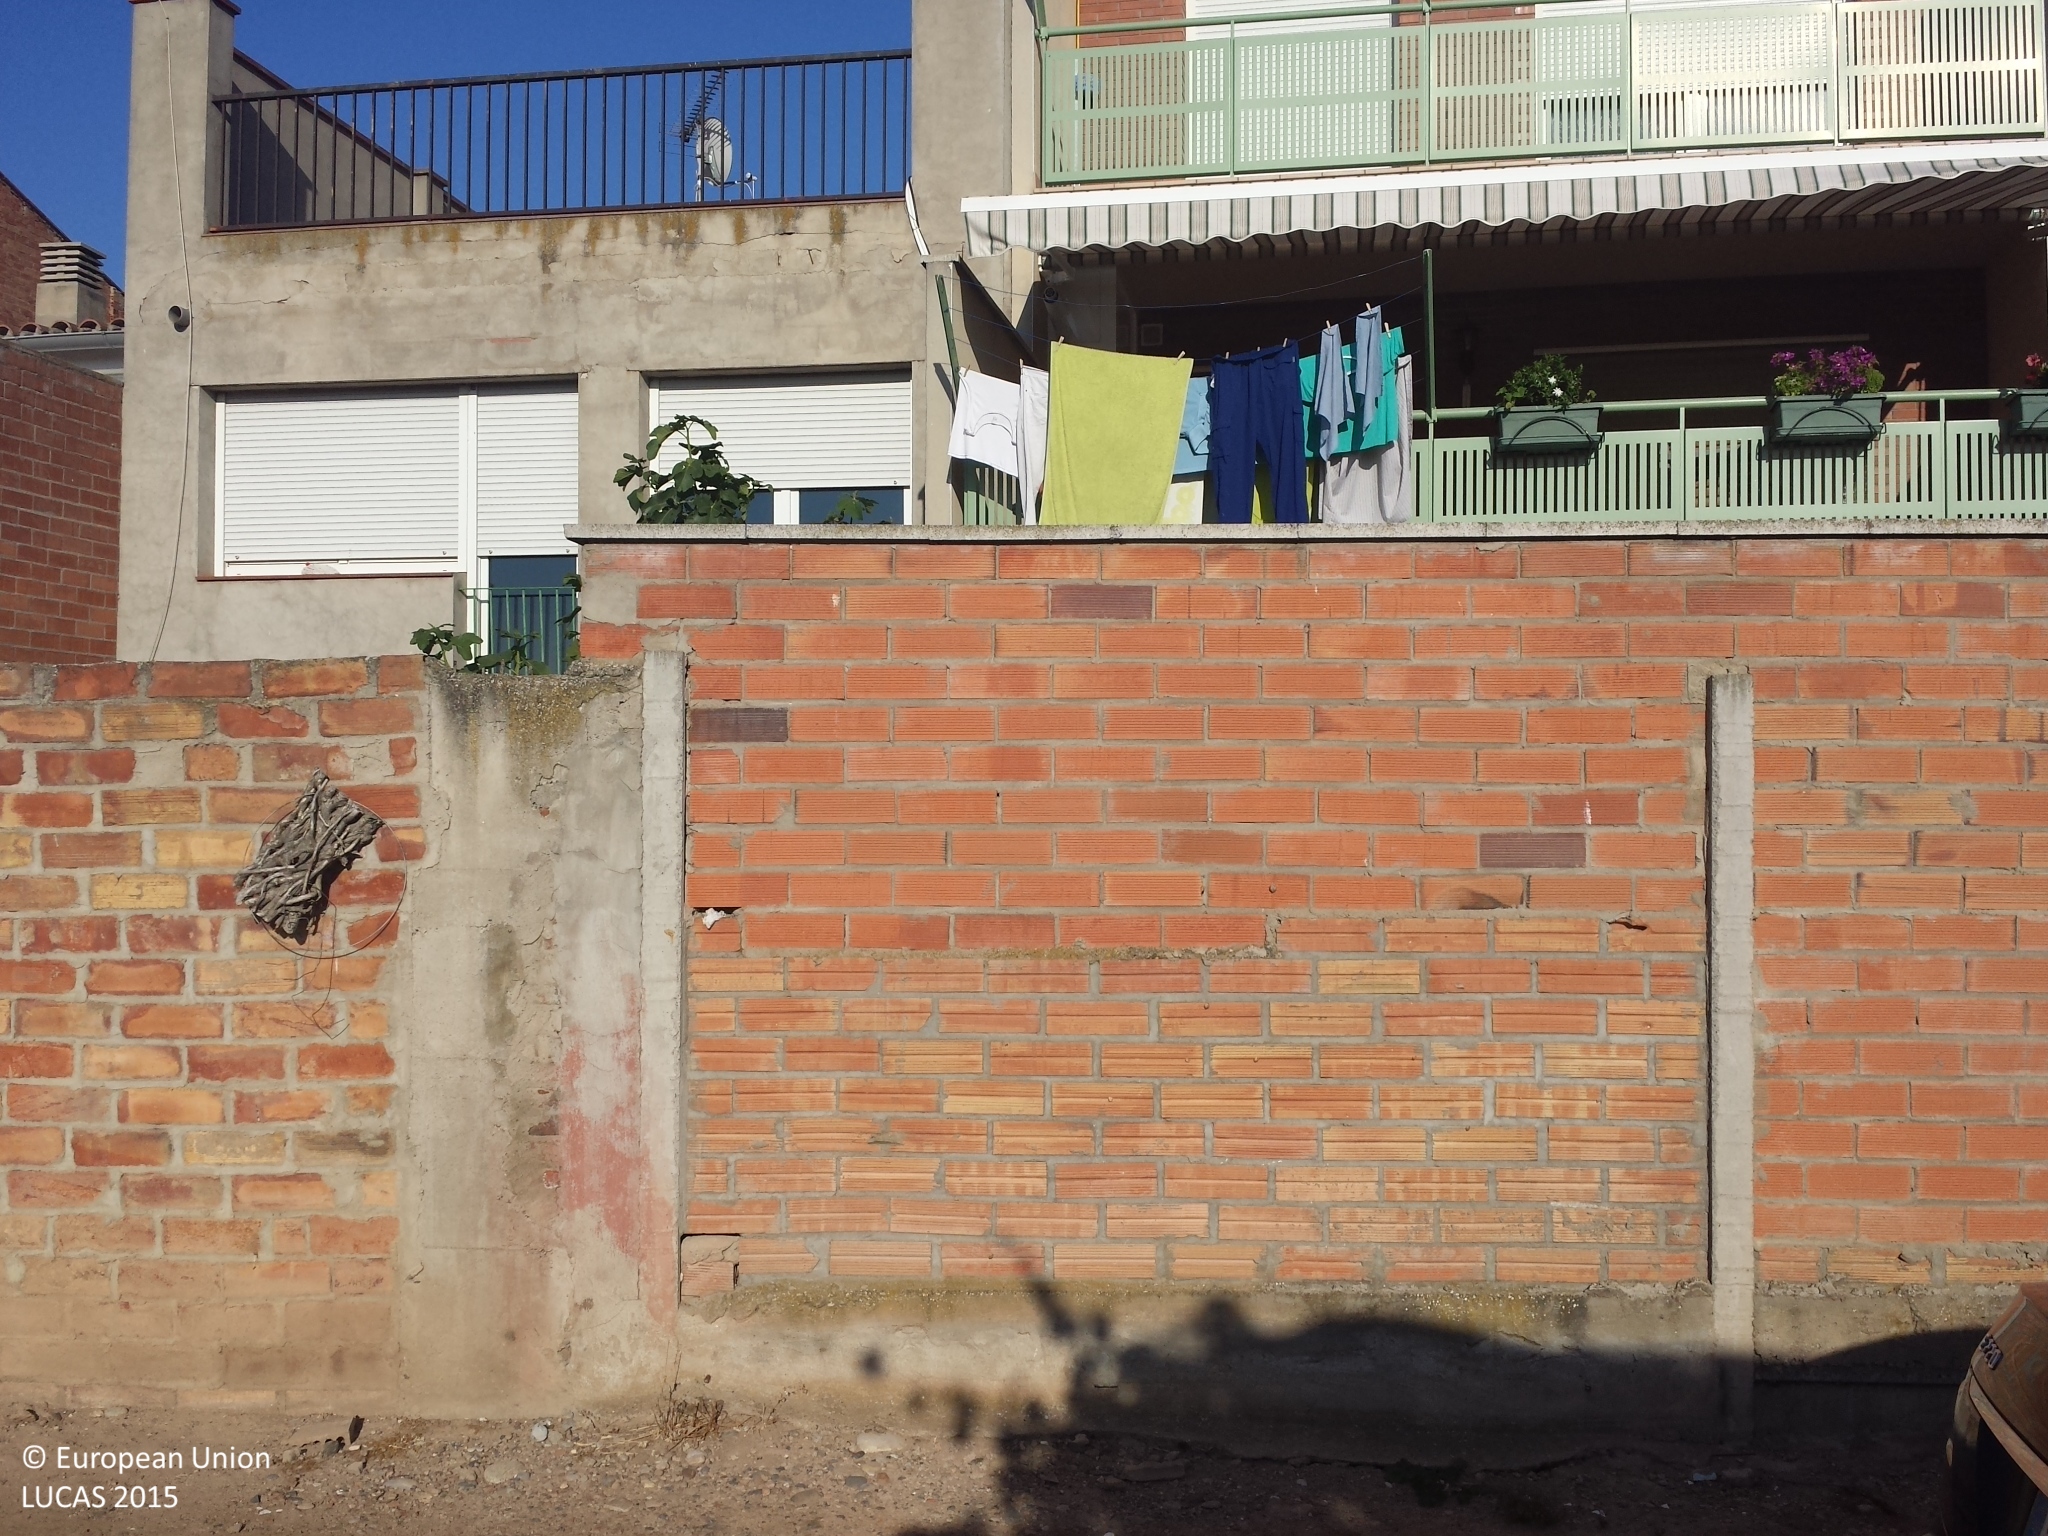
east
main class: Cropland
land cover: Tomatoes
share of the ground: 50 - 75 %
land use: Kitchen garden
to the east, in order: Tomatoes; Artificial constructions in urban areas
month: May
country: ES
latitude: 41.6714
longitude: 0.6064
